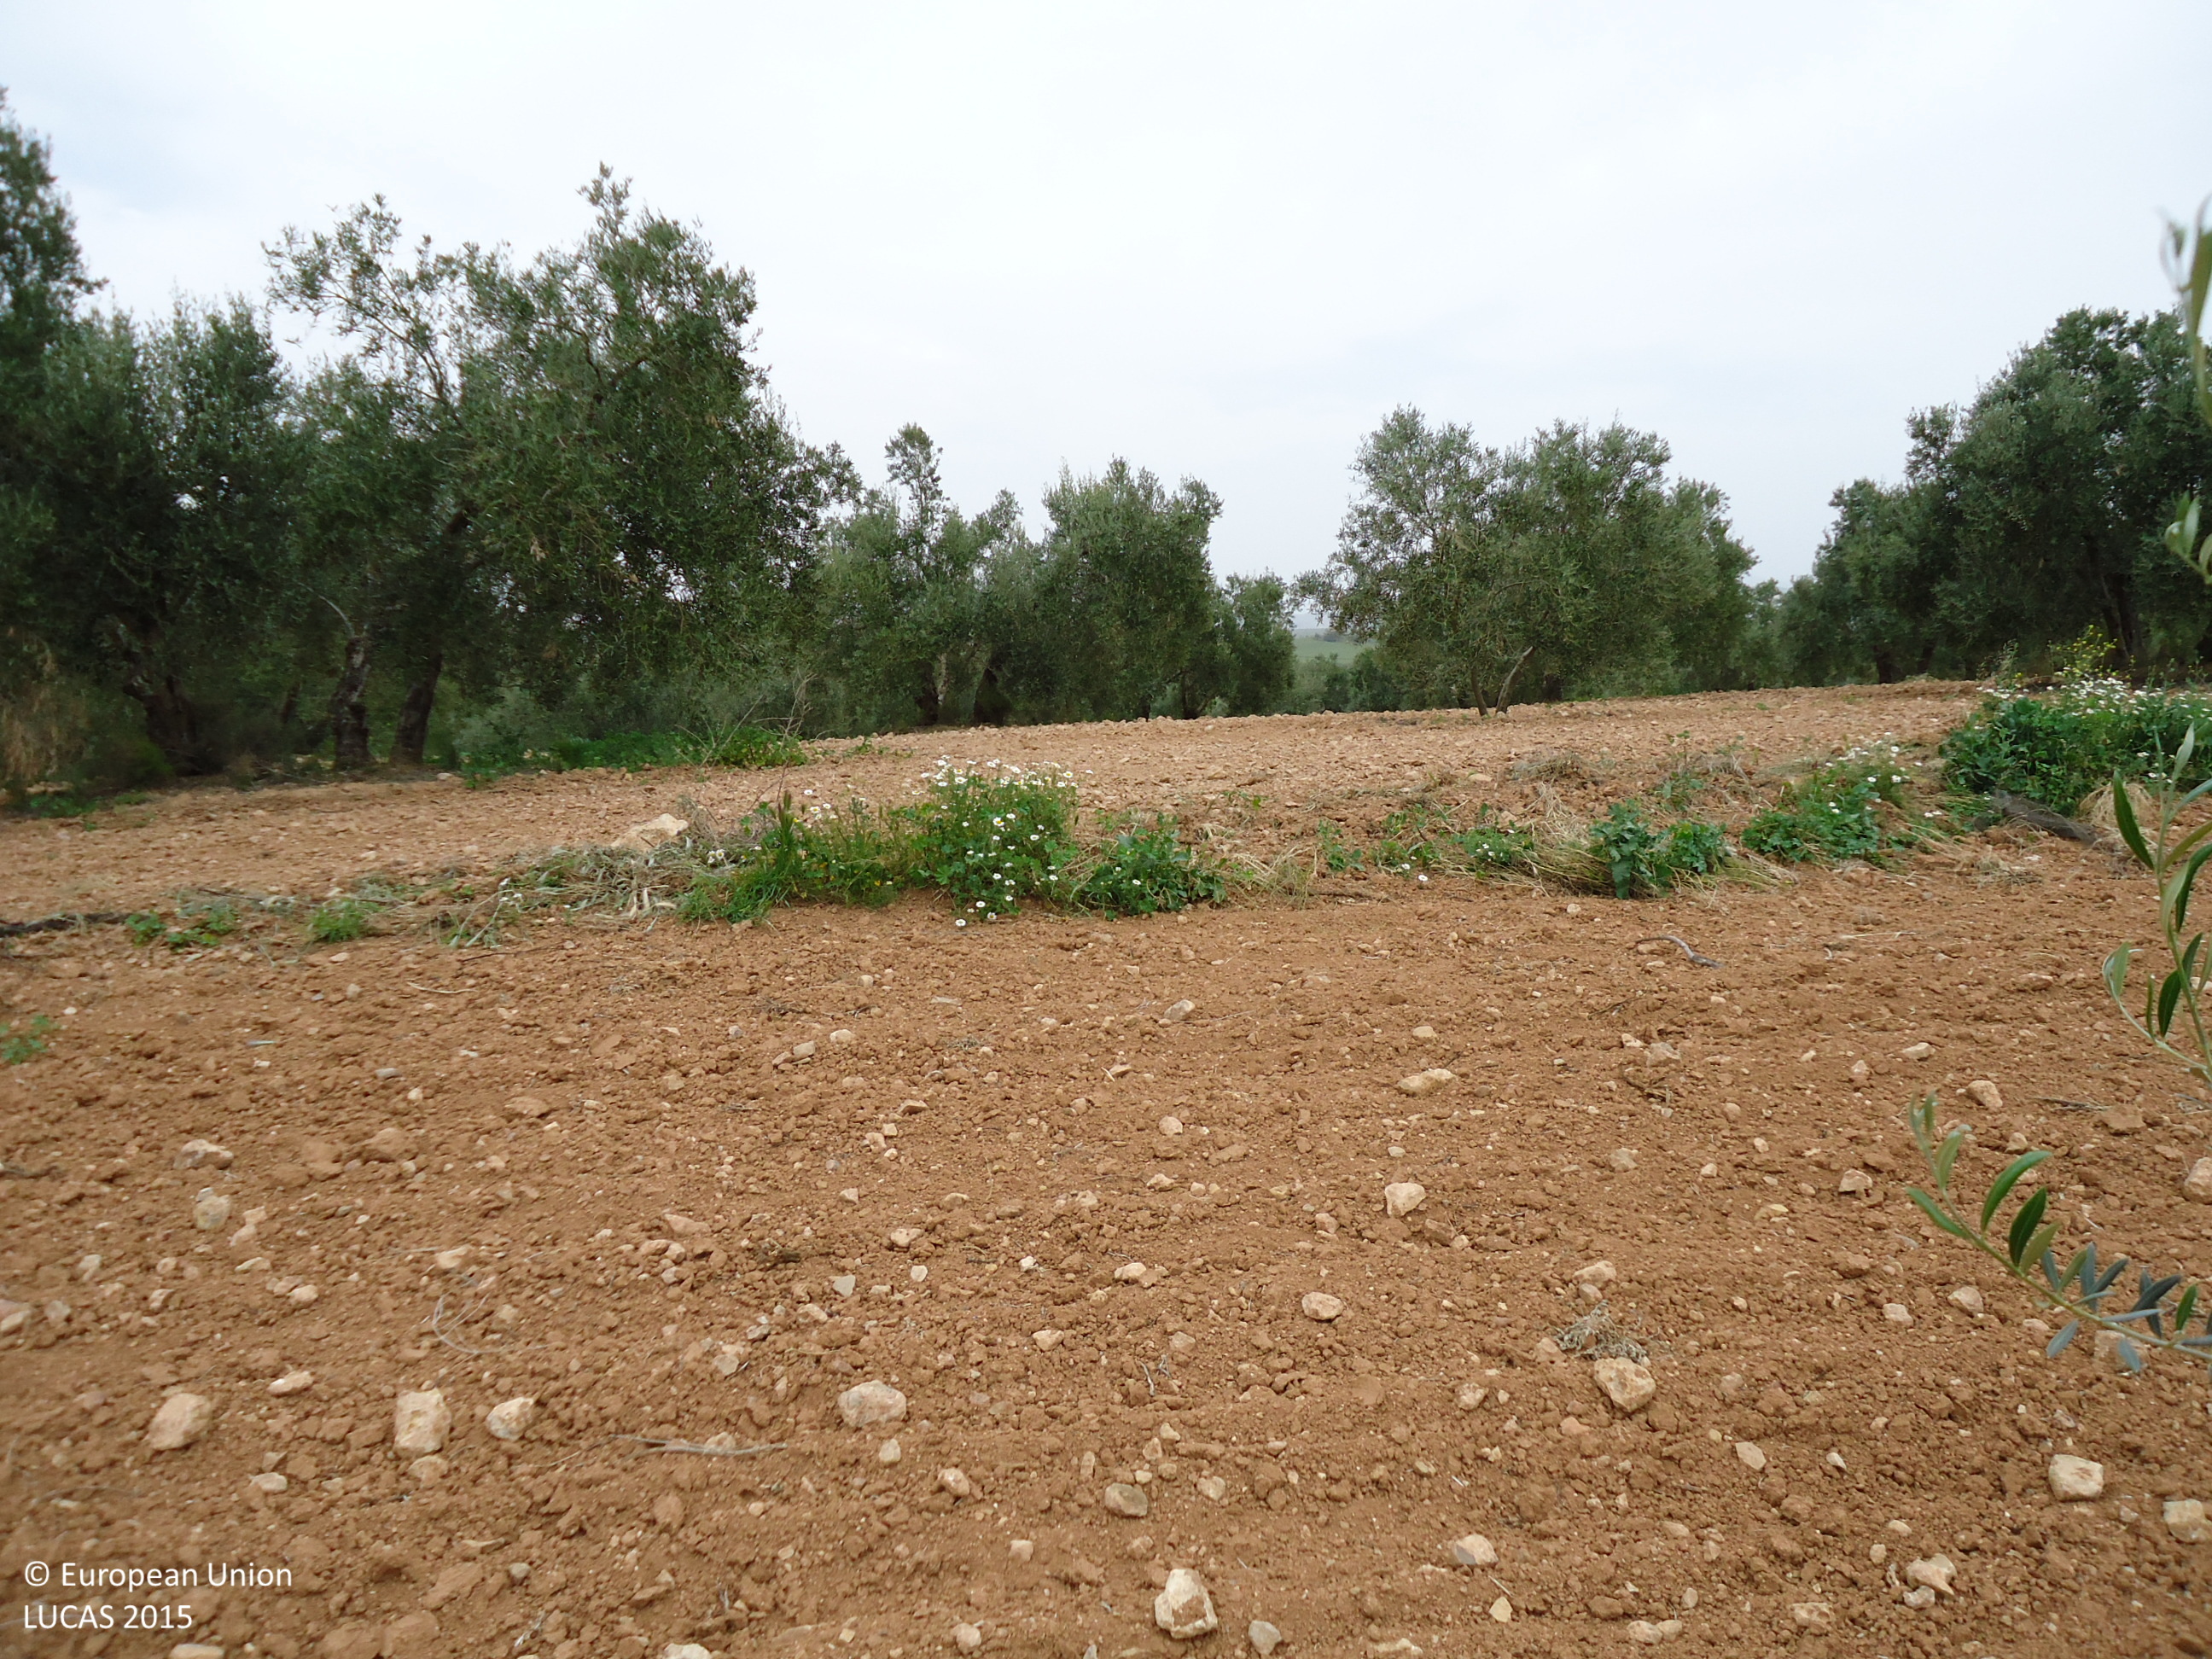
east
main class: Cropland
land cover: Olive groves
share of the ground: < 10 %
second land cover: Other bare soil
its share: > 75 %
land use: Agriculture (excluding fallow land and kitchen gardens)
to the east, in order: Olive groves; Other bare soil; Grass margins; Tracks; Olive groves
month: April
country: ES
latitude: 37.0098
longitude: -5.0054
